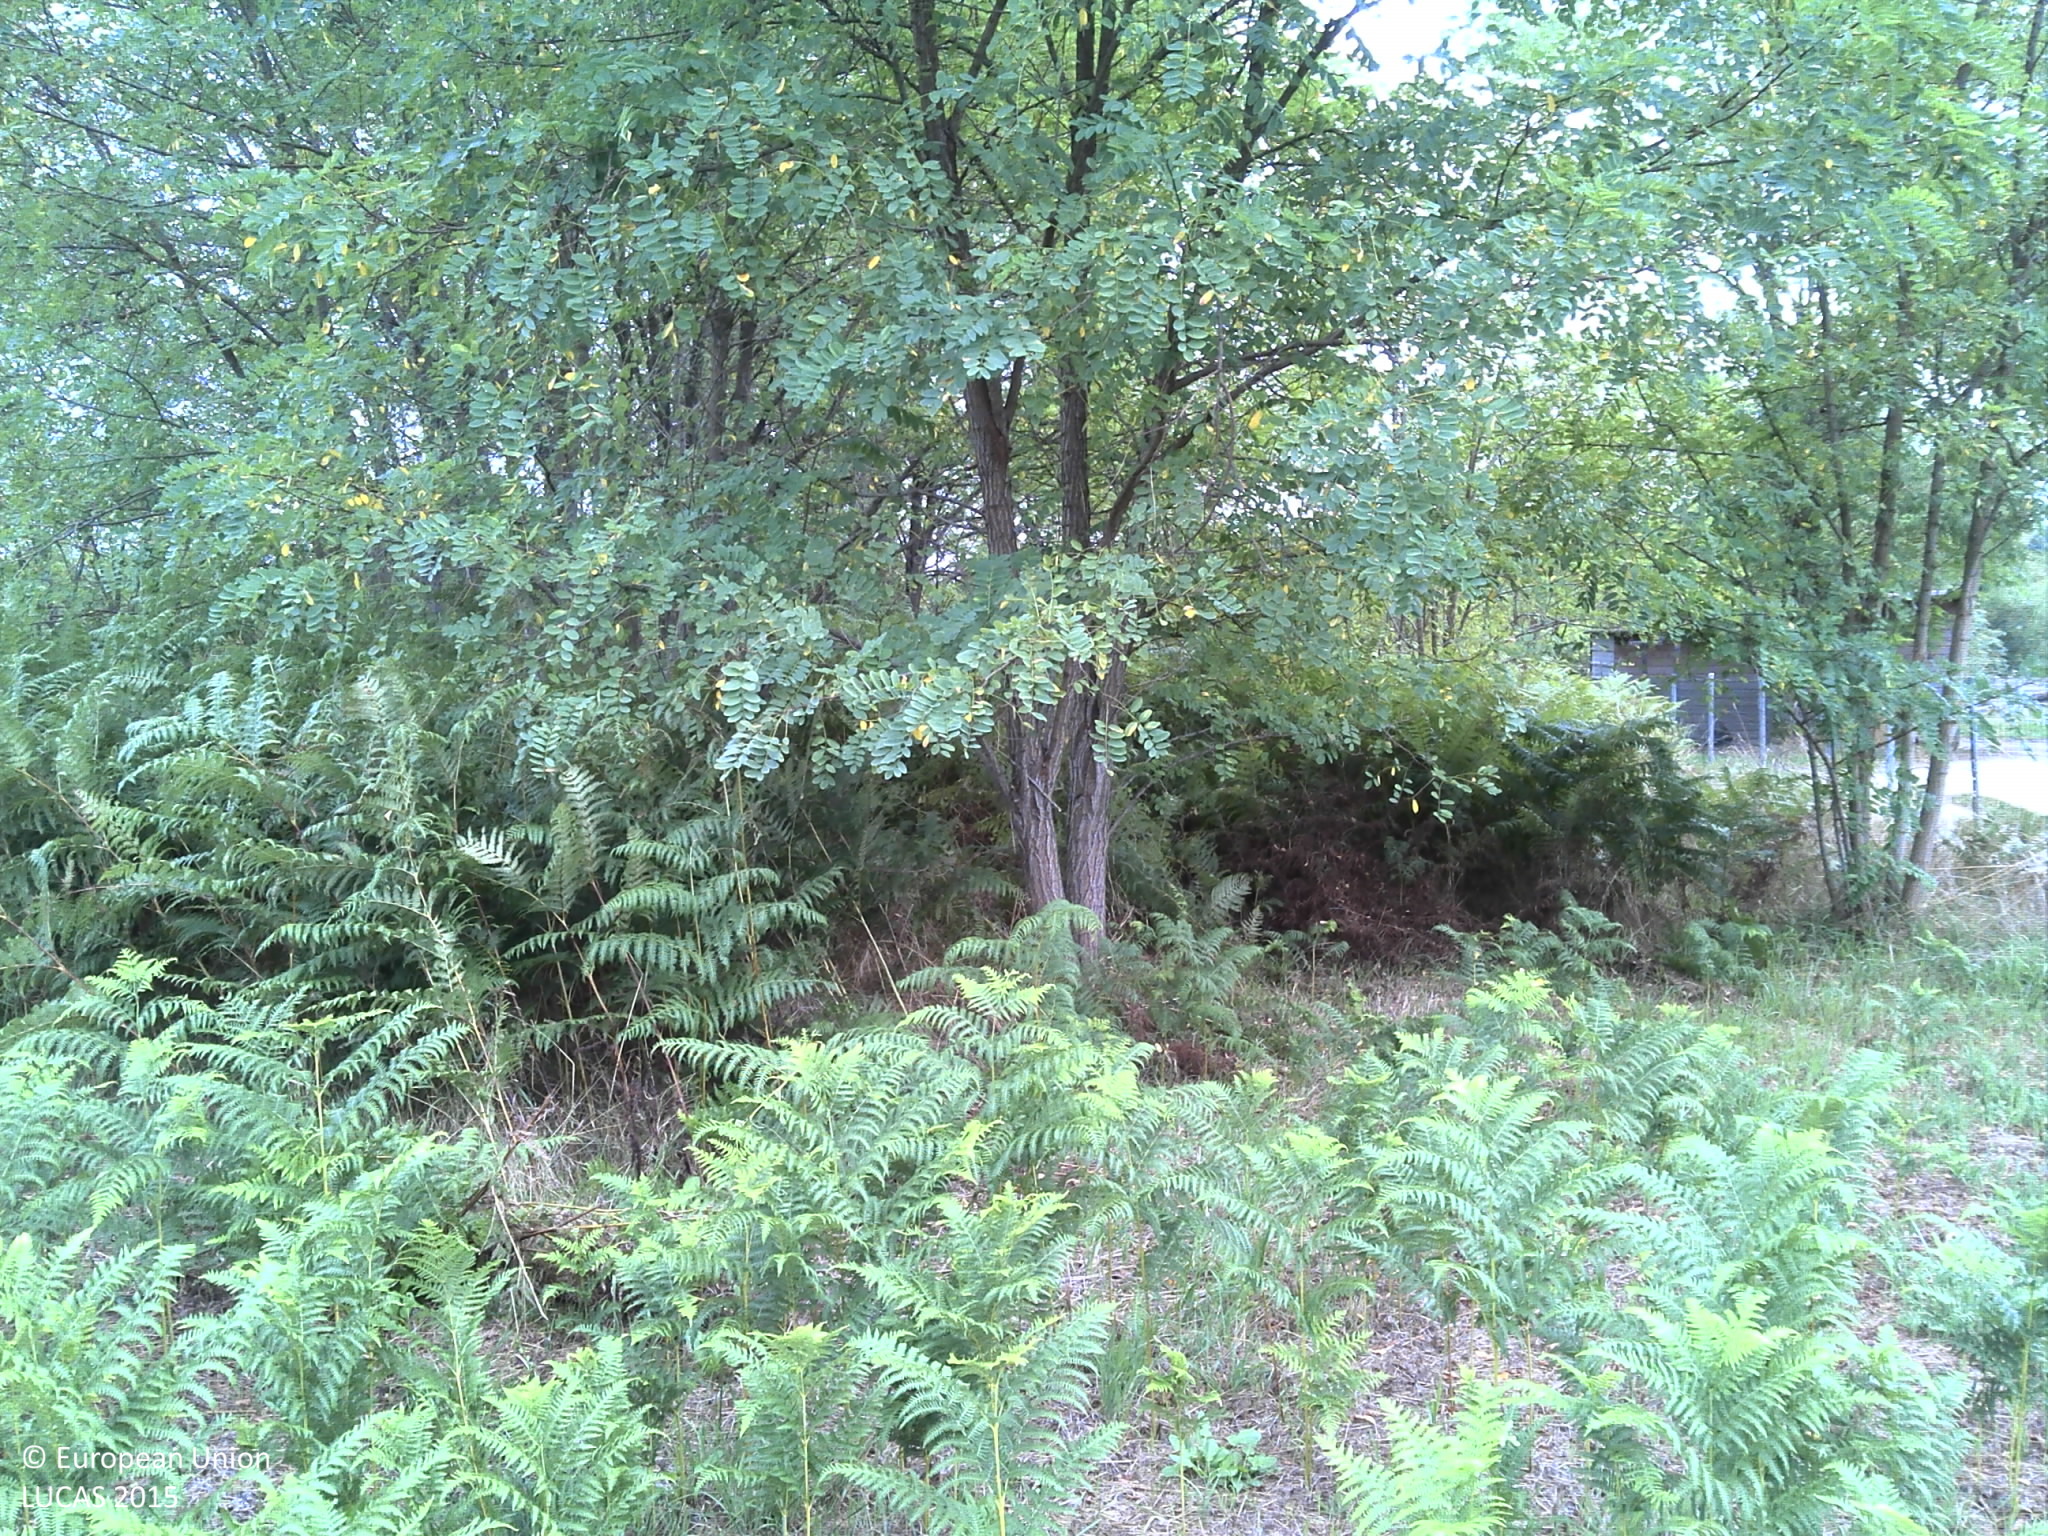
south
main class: Grassland
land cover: Spontaneously vegetated surfaces
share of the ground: > 75 %
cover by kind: herbaceous plants 95 %, shrubs 5 %
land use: Semi-natural and natural areas not in use
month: August
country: FR
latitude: 45.2639
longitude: -0.5605
